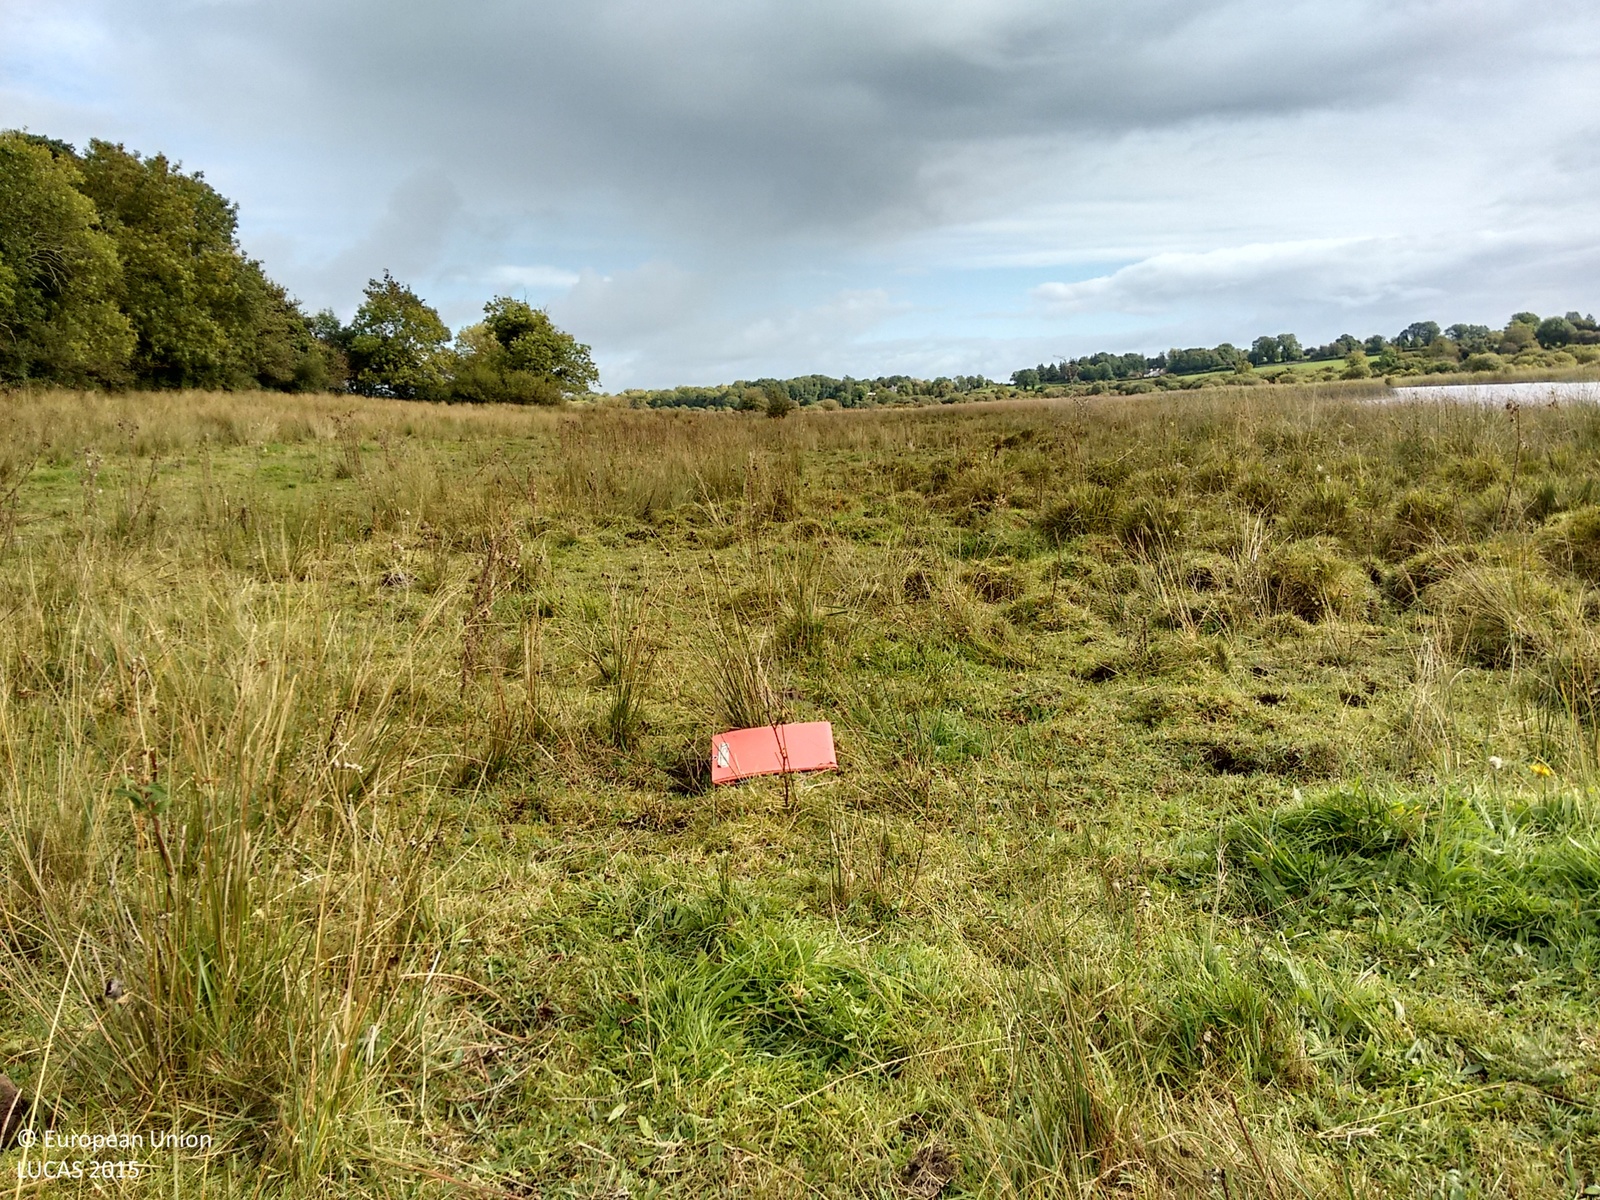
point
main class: Grassland
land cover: Grassland without tree/shrub cover
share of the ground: > 75 %
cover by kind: herbaceous plants 100 %
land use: Agriculture (excluding fallow land and kitchen gardens)
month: October
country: IE
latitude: 53.8179
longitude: -8.1805
